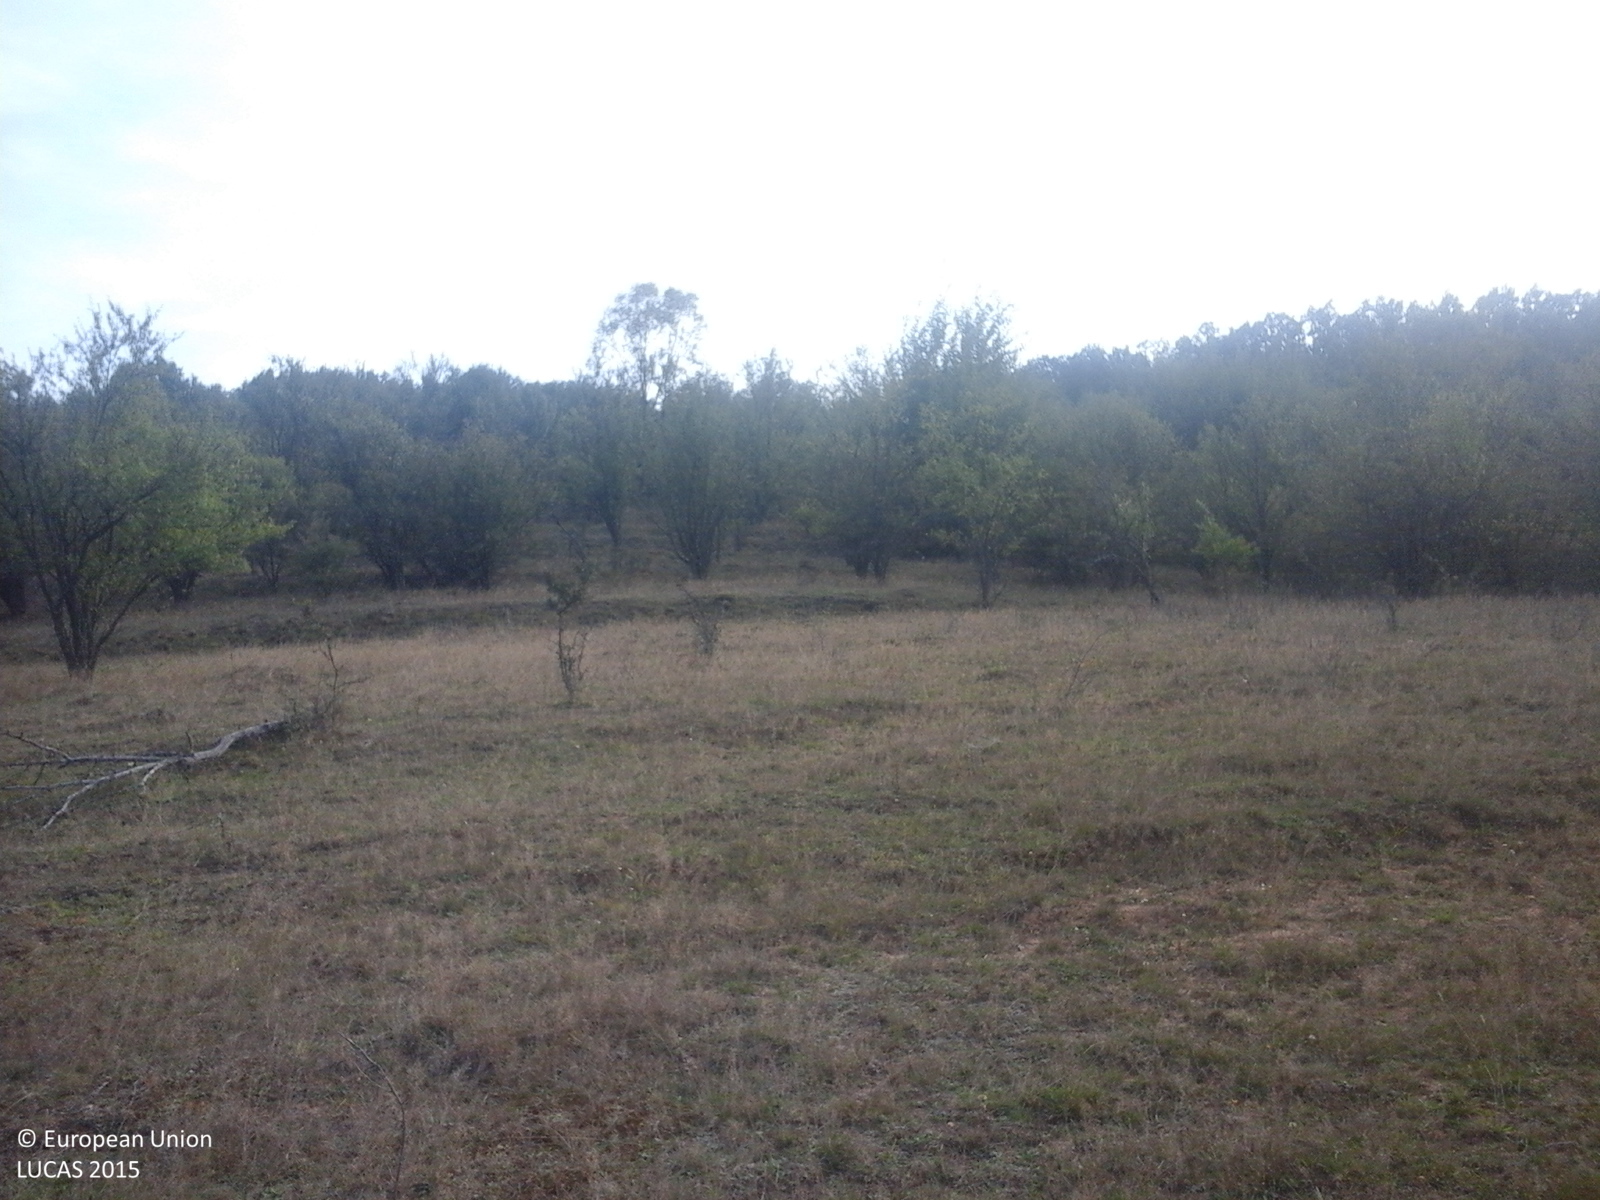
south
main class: Cropland
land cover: Other fruit trees and berries
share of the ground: > 75 %
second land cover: Grassland without tree/shrub cover
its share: > 75 %
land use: Agriculture (excluding fallow land and kitchen gardens)
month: September
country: RO
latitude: 47.0200
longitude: 23.2355
